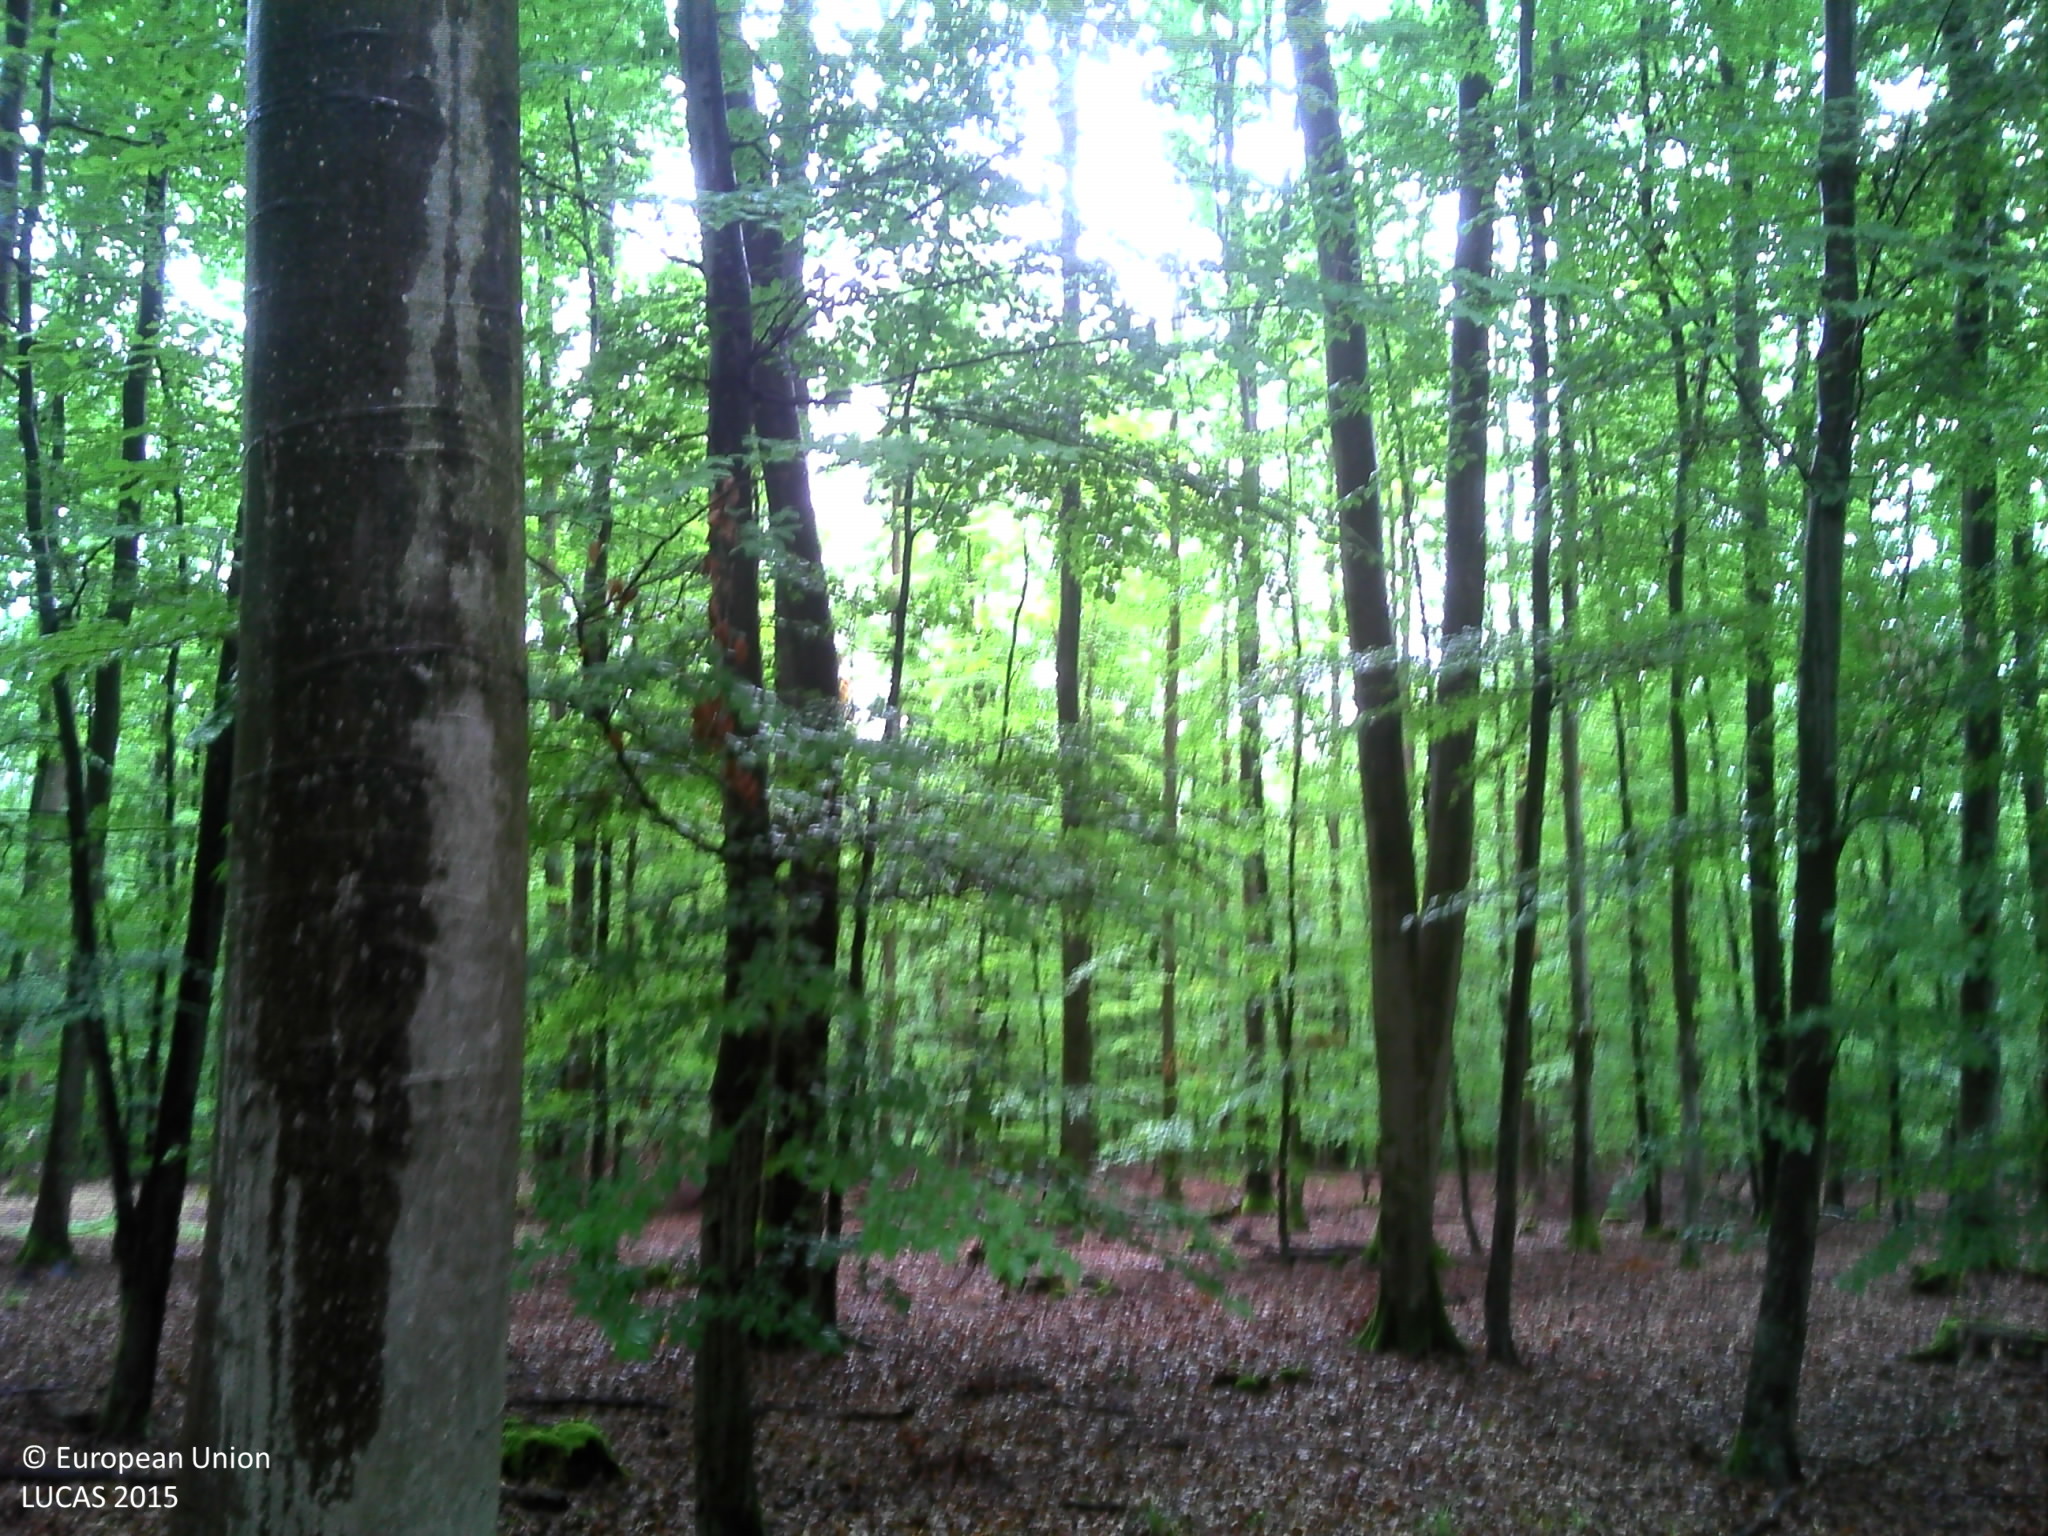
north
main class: Woodland
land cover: Broadleaved woodland
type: beech forest
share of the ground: > 75 %
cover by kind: broadleaved forest trees 100 %
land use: Forestry
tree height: > 5 m
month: July
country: FR
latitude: 48.9455
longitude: 7.2561
